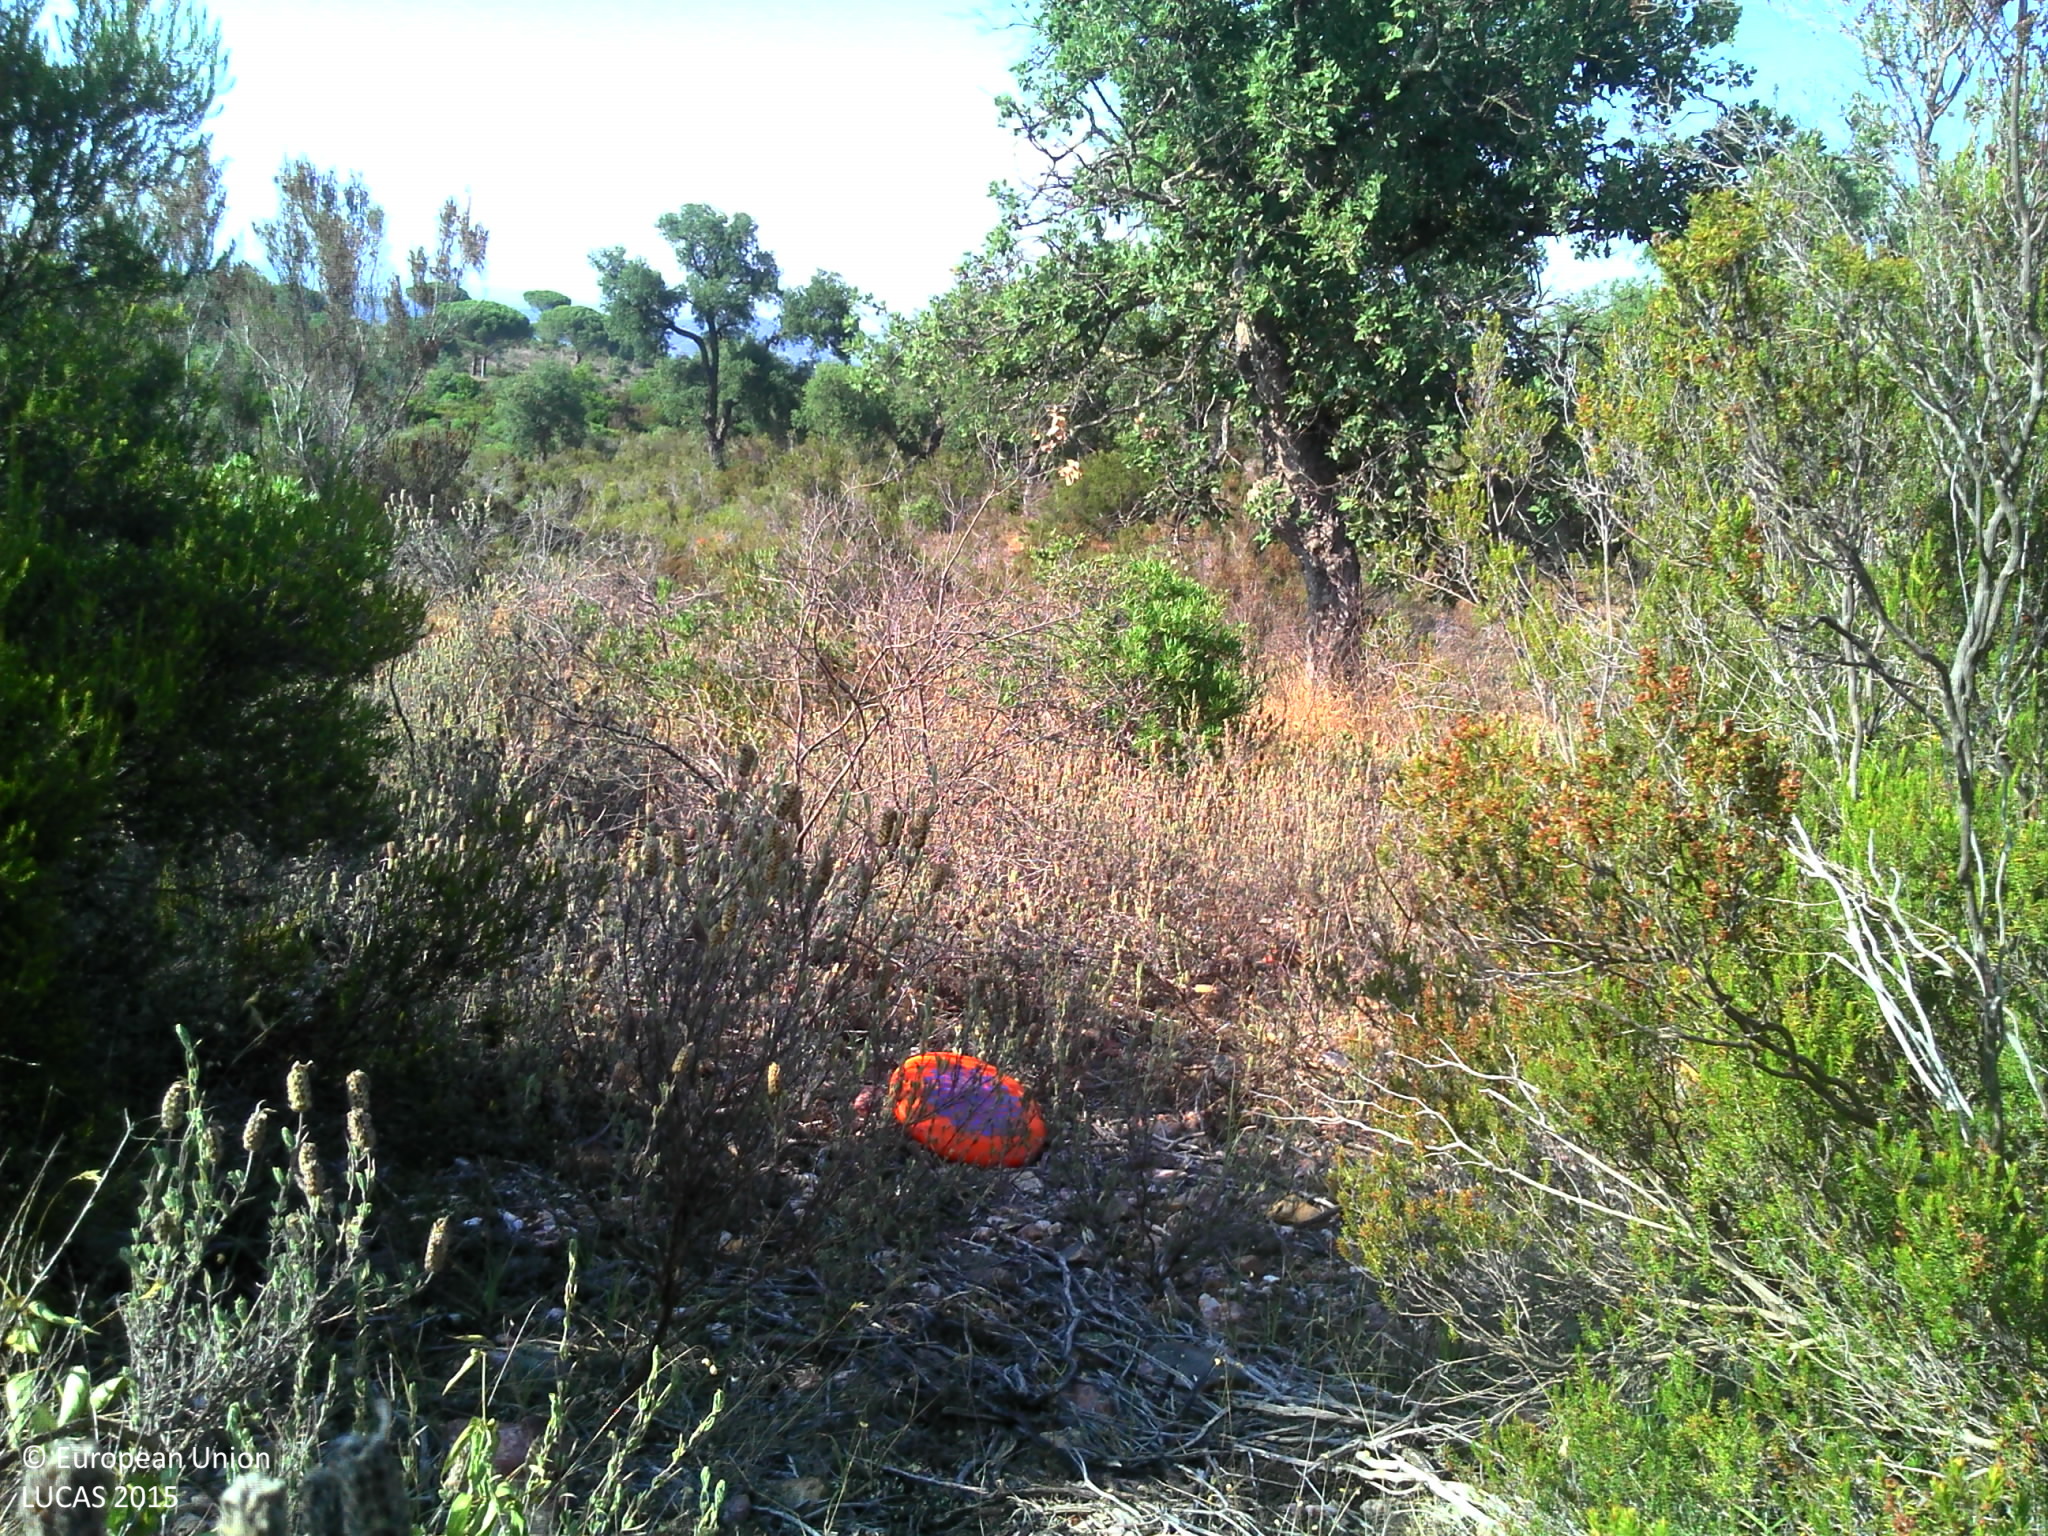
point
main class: Shrubland
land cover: Shrubland with sparse tree cover
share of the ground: > 75 %
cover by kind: shrubs 95 %, broadleaved forest trees 5 %
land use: Semi-natural and natural areas not in use
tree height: > 5 m
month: July
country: FR
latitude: 43.3488
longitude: 6.3943
